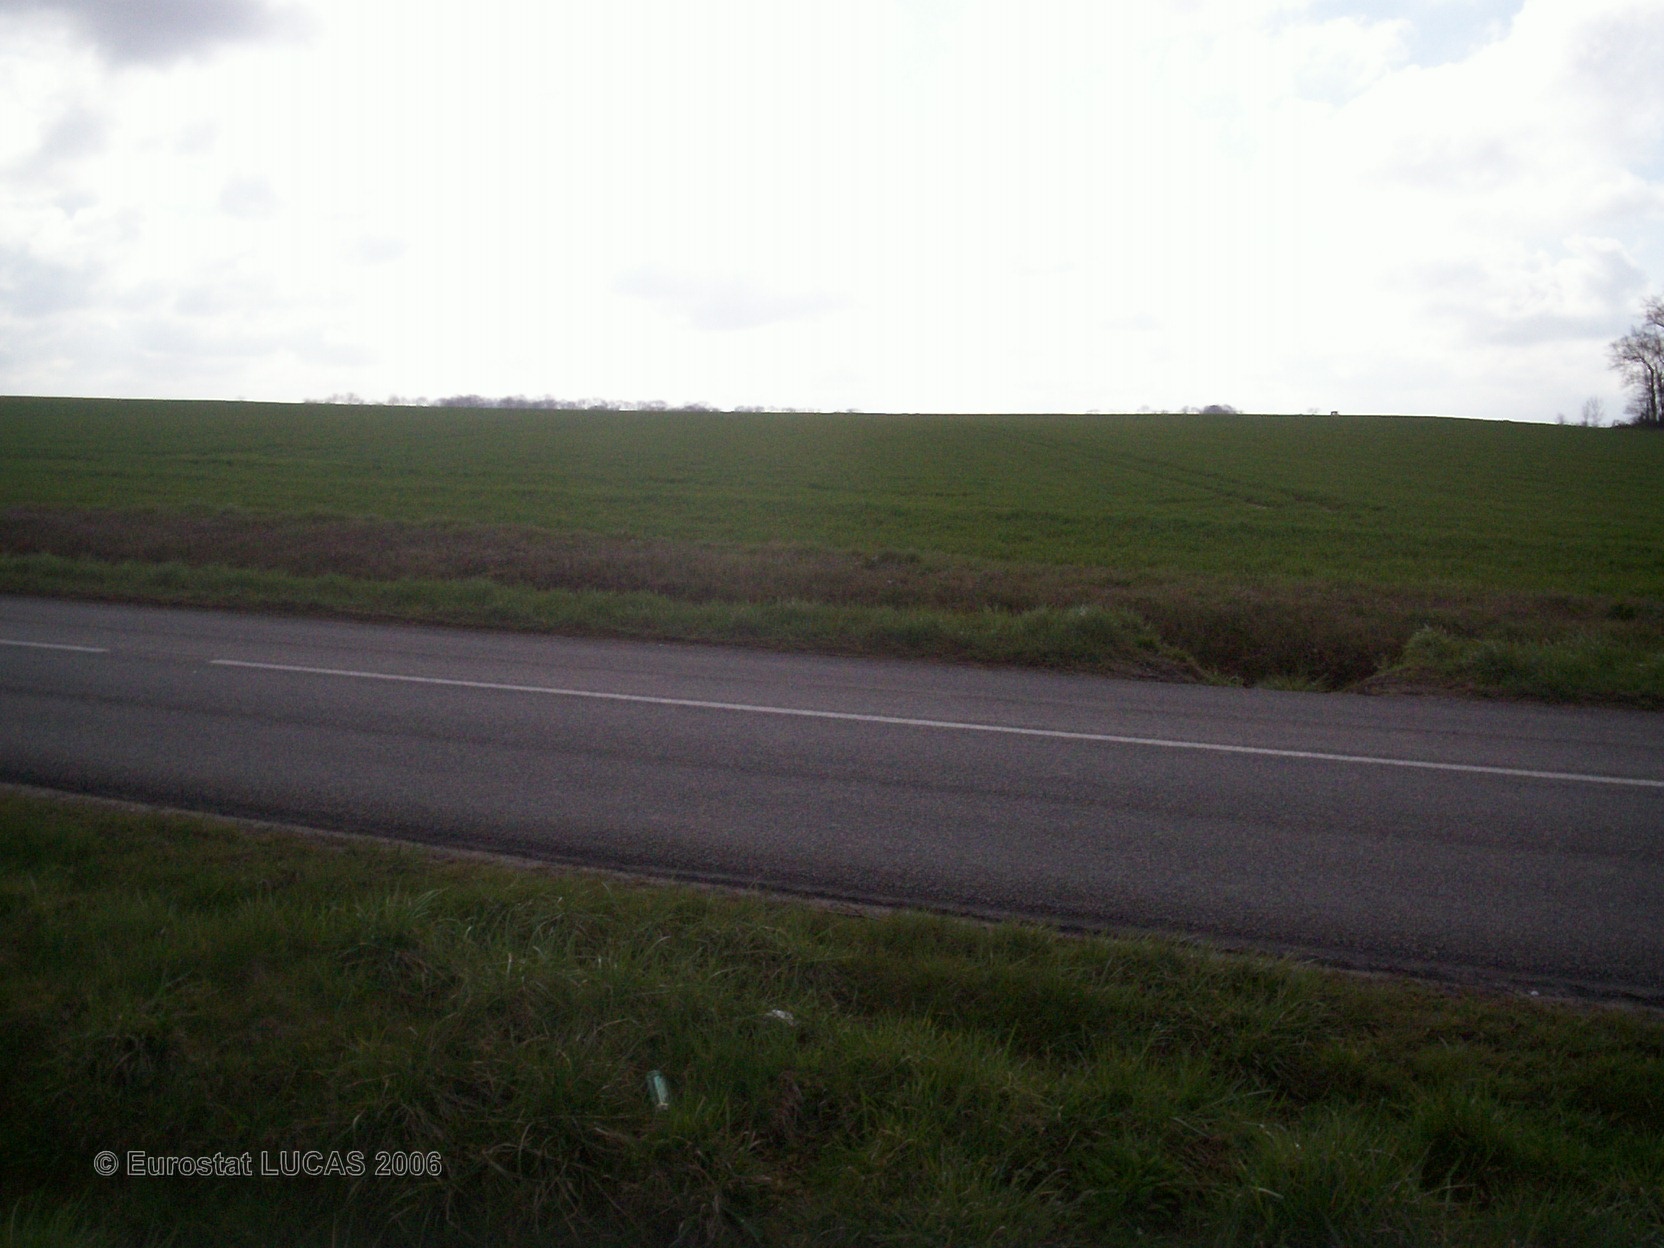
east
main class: Grassland
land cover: Grassland without tree/shrub cover
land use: Agriculture (excluding fallow land and kitchen gardens)
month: April
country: FR
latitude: 49.5679
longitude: 0.9201
